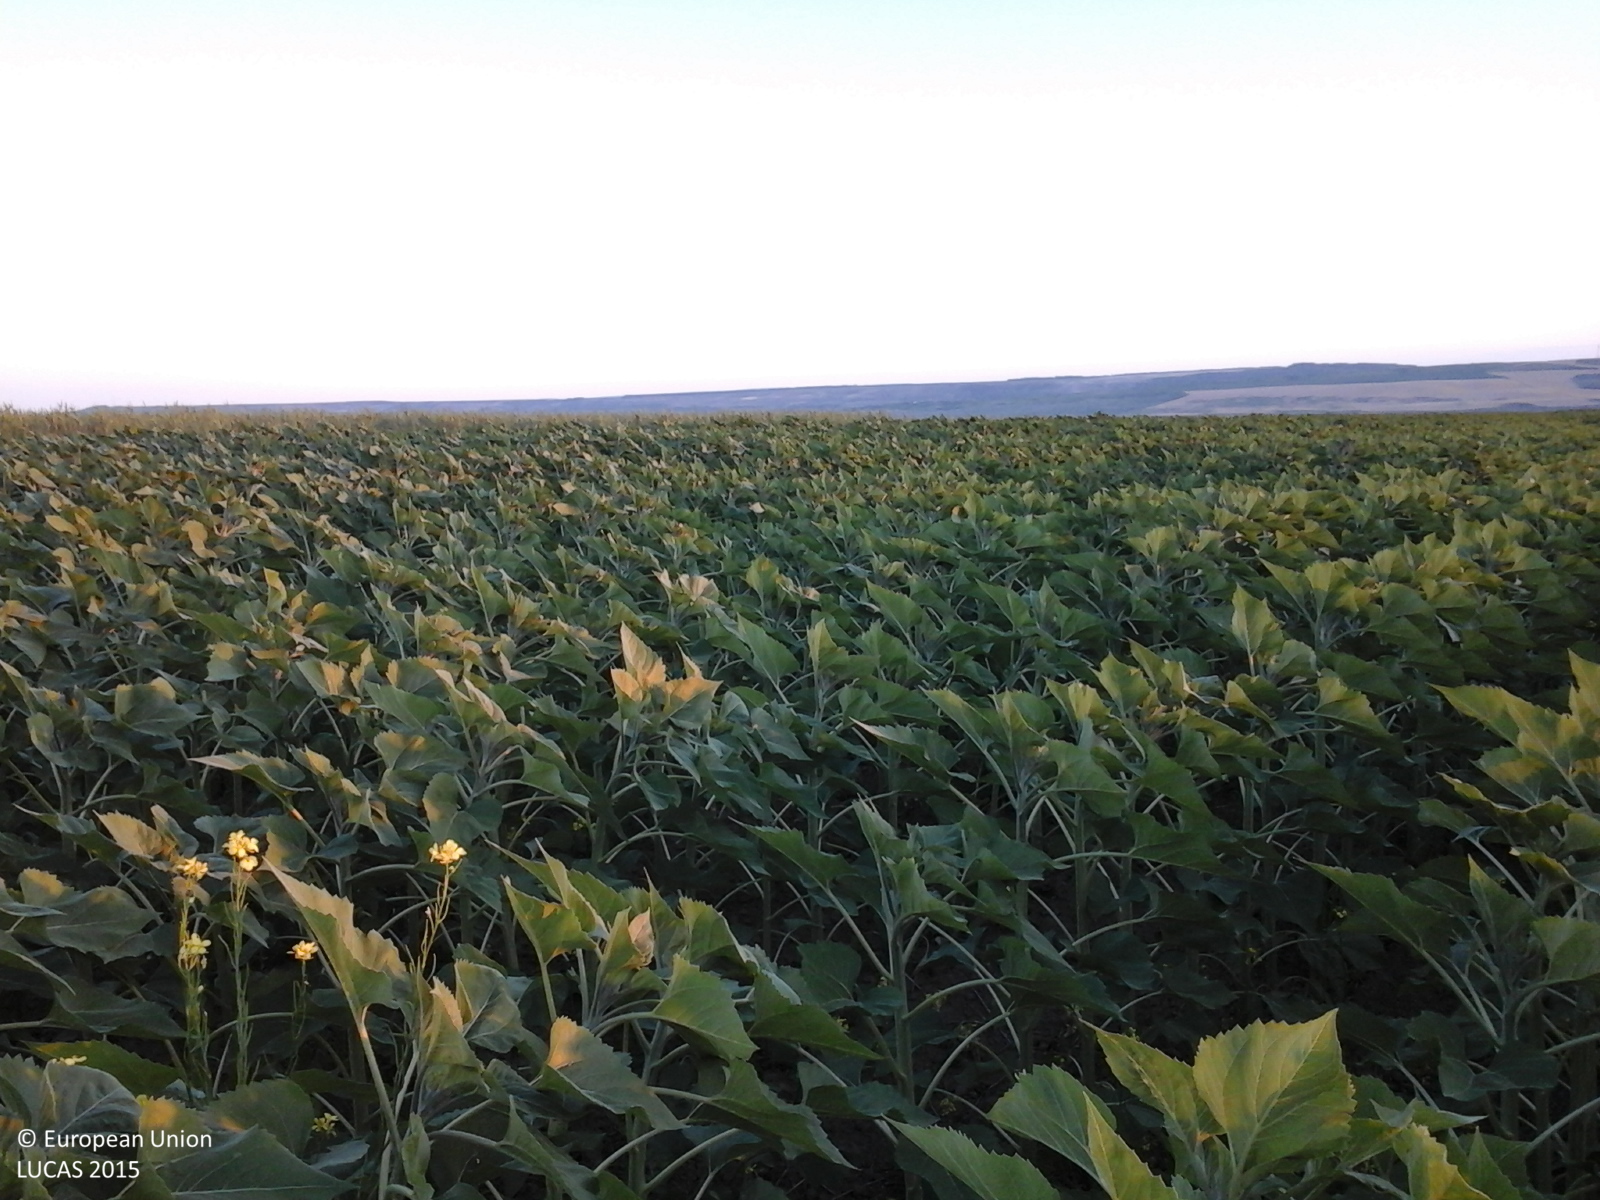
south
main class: Cropland
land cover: Sunflower
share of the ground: 50 - 75 %
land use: Agriculture (excluding fallow land and kitchen gardens)
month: June
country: RO
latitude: 46.9707
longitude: 28.0742
